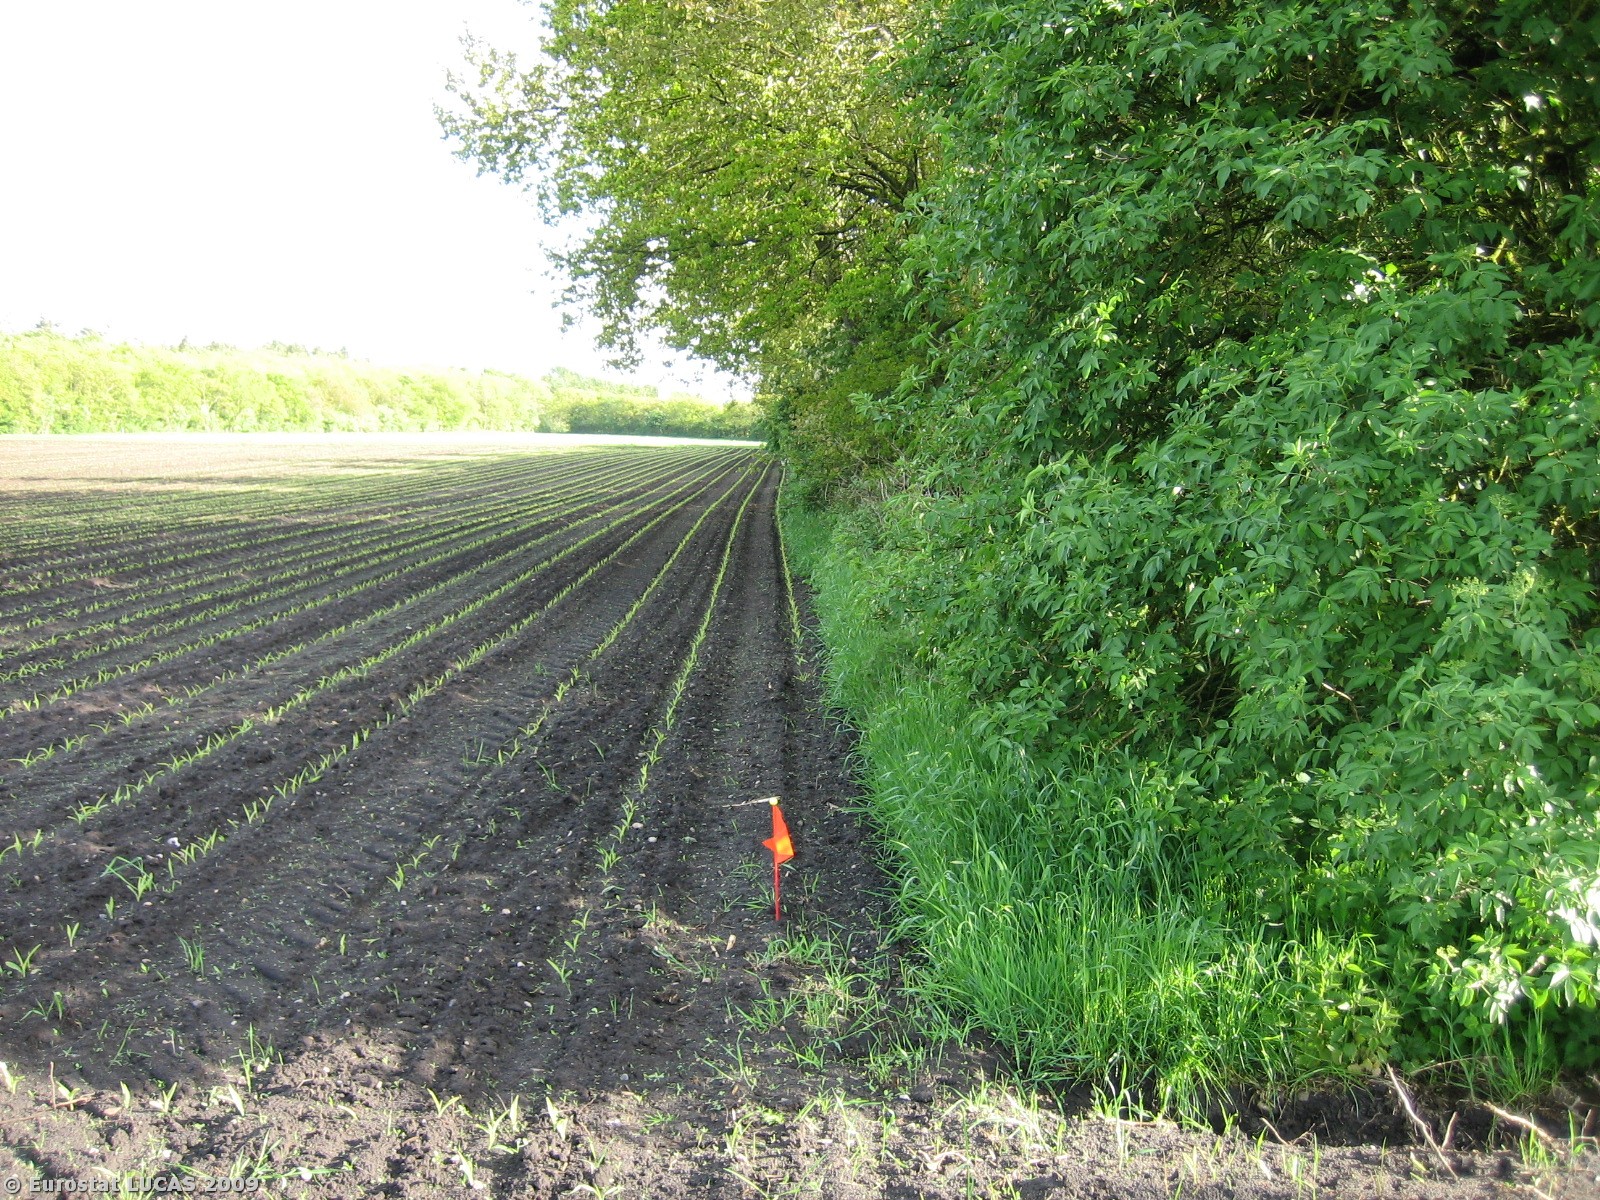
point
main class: Cropland
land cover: Maize
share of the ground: < 10 %
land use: Agriculture (excluding fallow land and kitchen gardens)
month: May
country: DK
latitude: 56.2354
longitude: 8.7270
